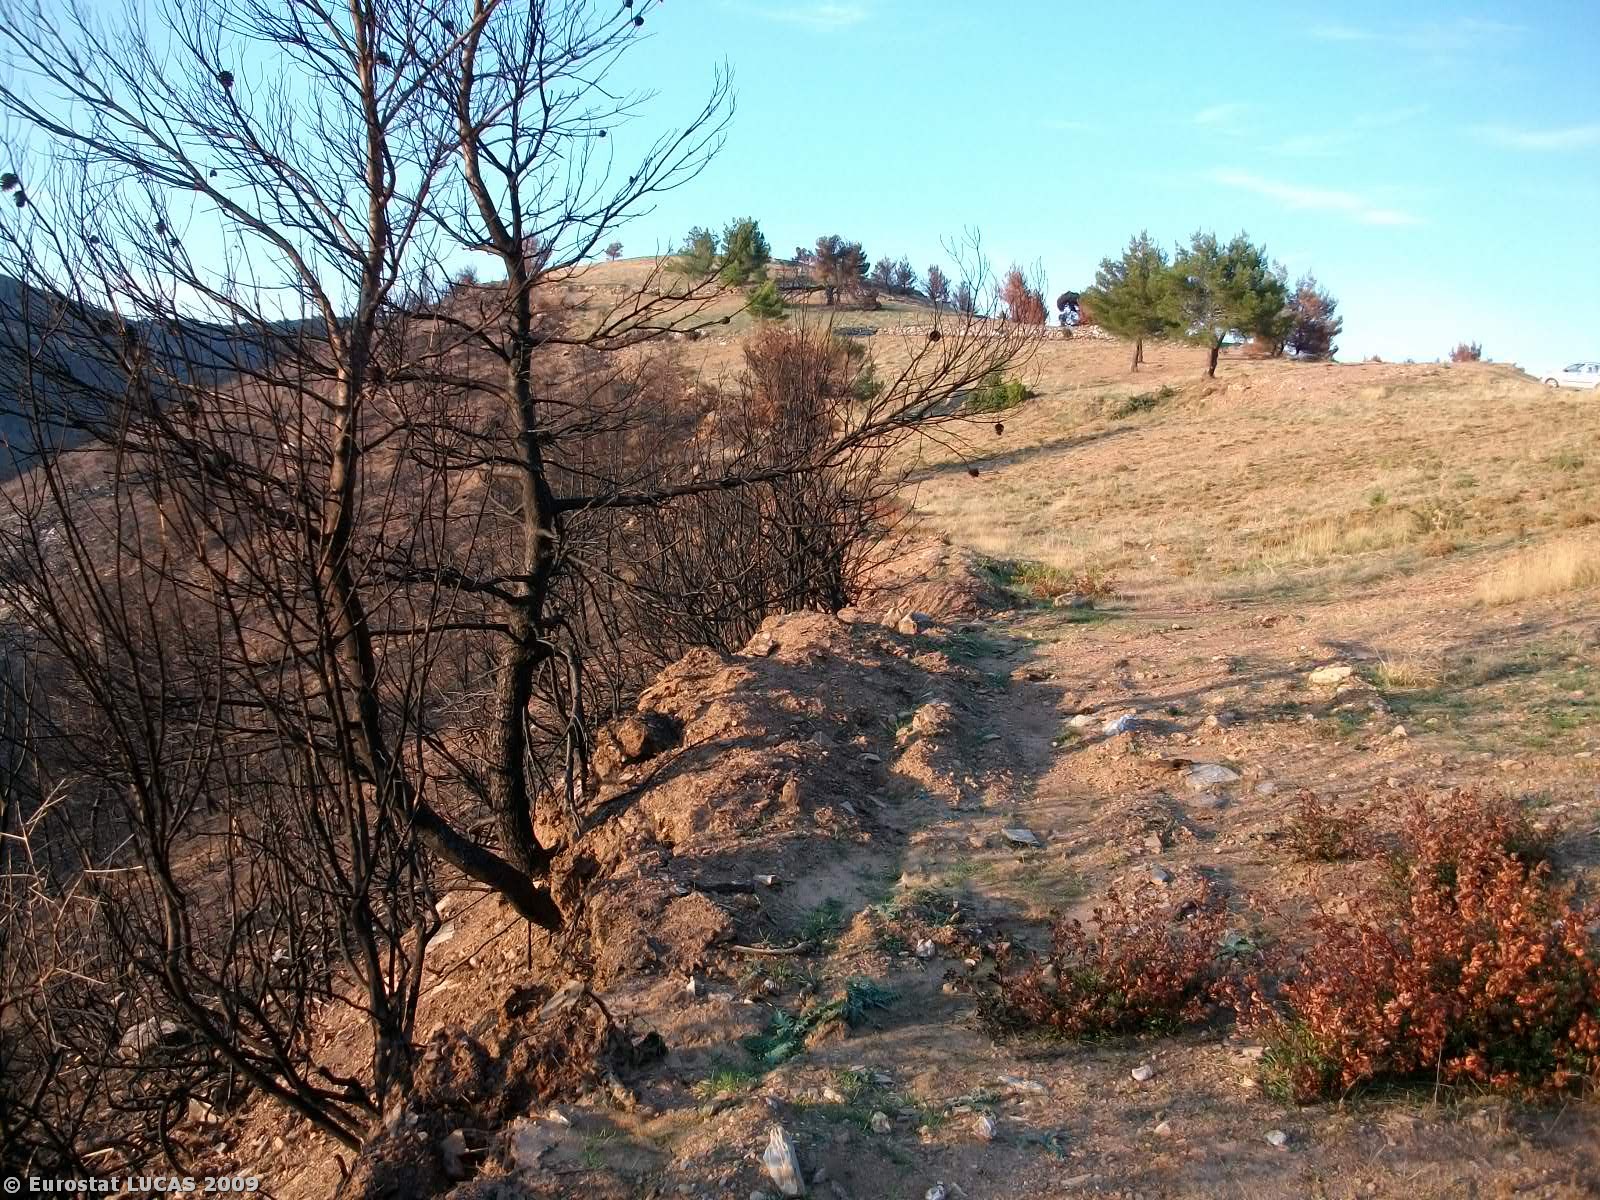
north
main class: Grassland
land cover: Grassland with sparse tree/shrub cover
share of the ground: > 75 %
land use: Unused
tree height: > 5 m
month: September
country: GR
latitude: 38.2367
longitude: 23.9594
